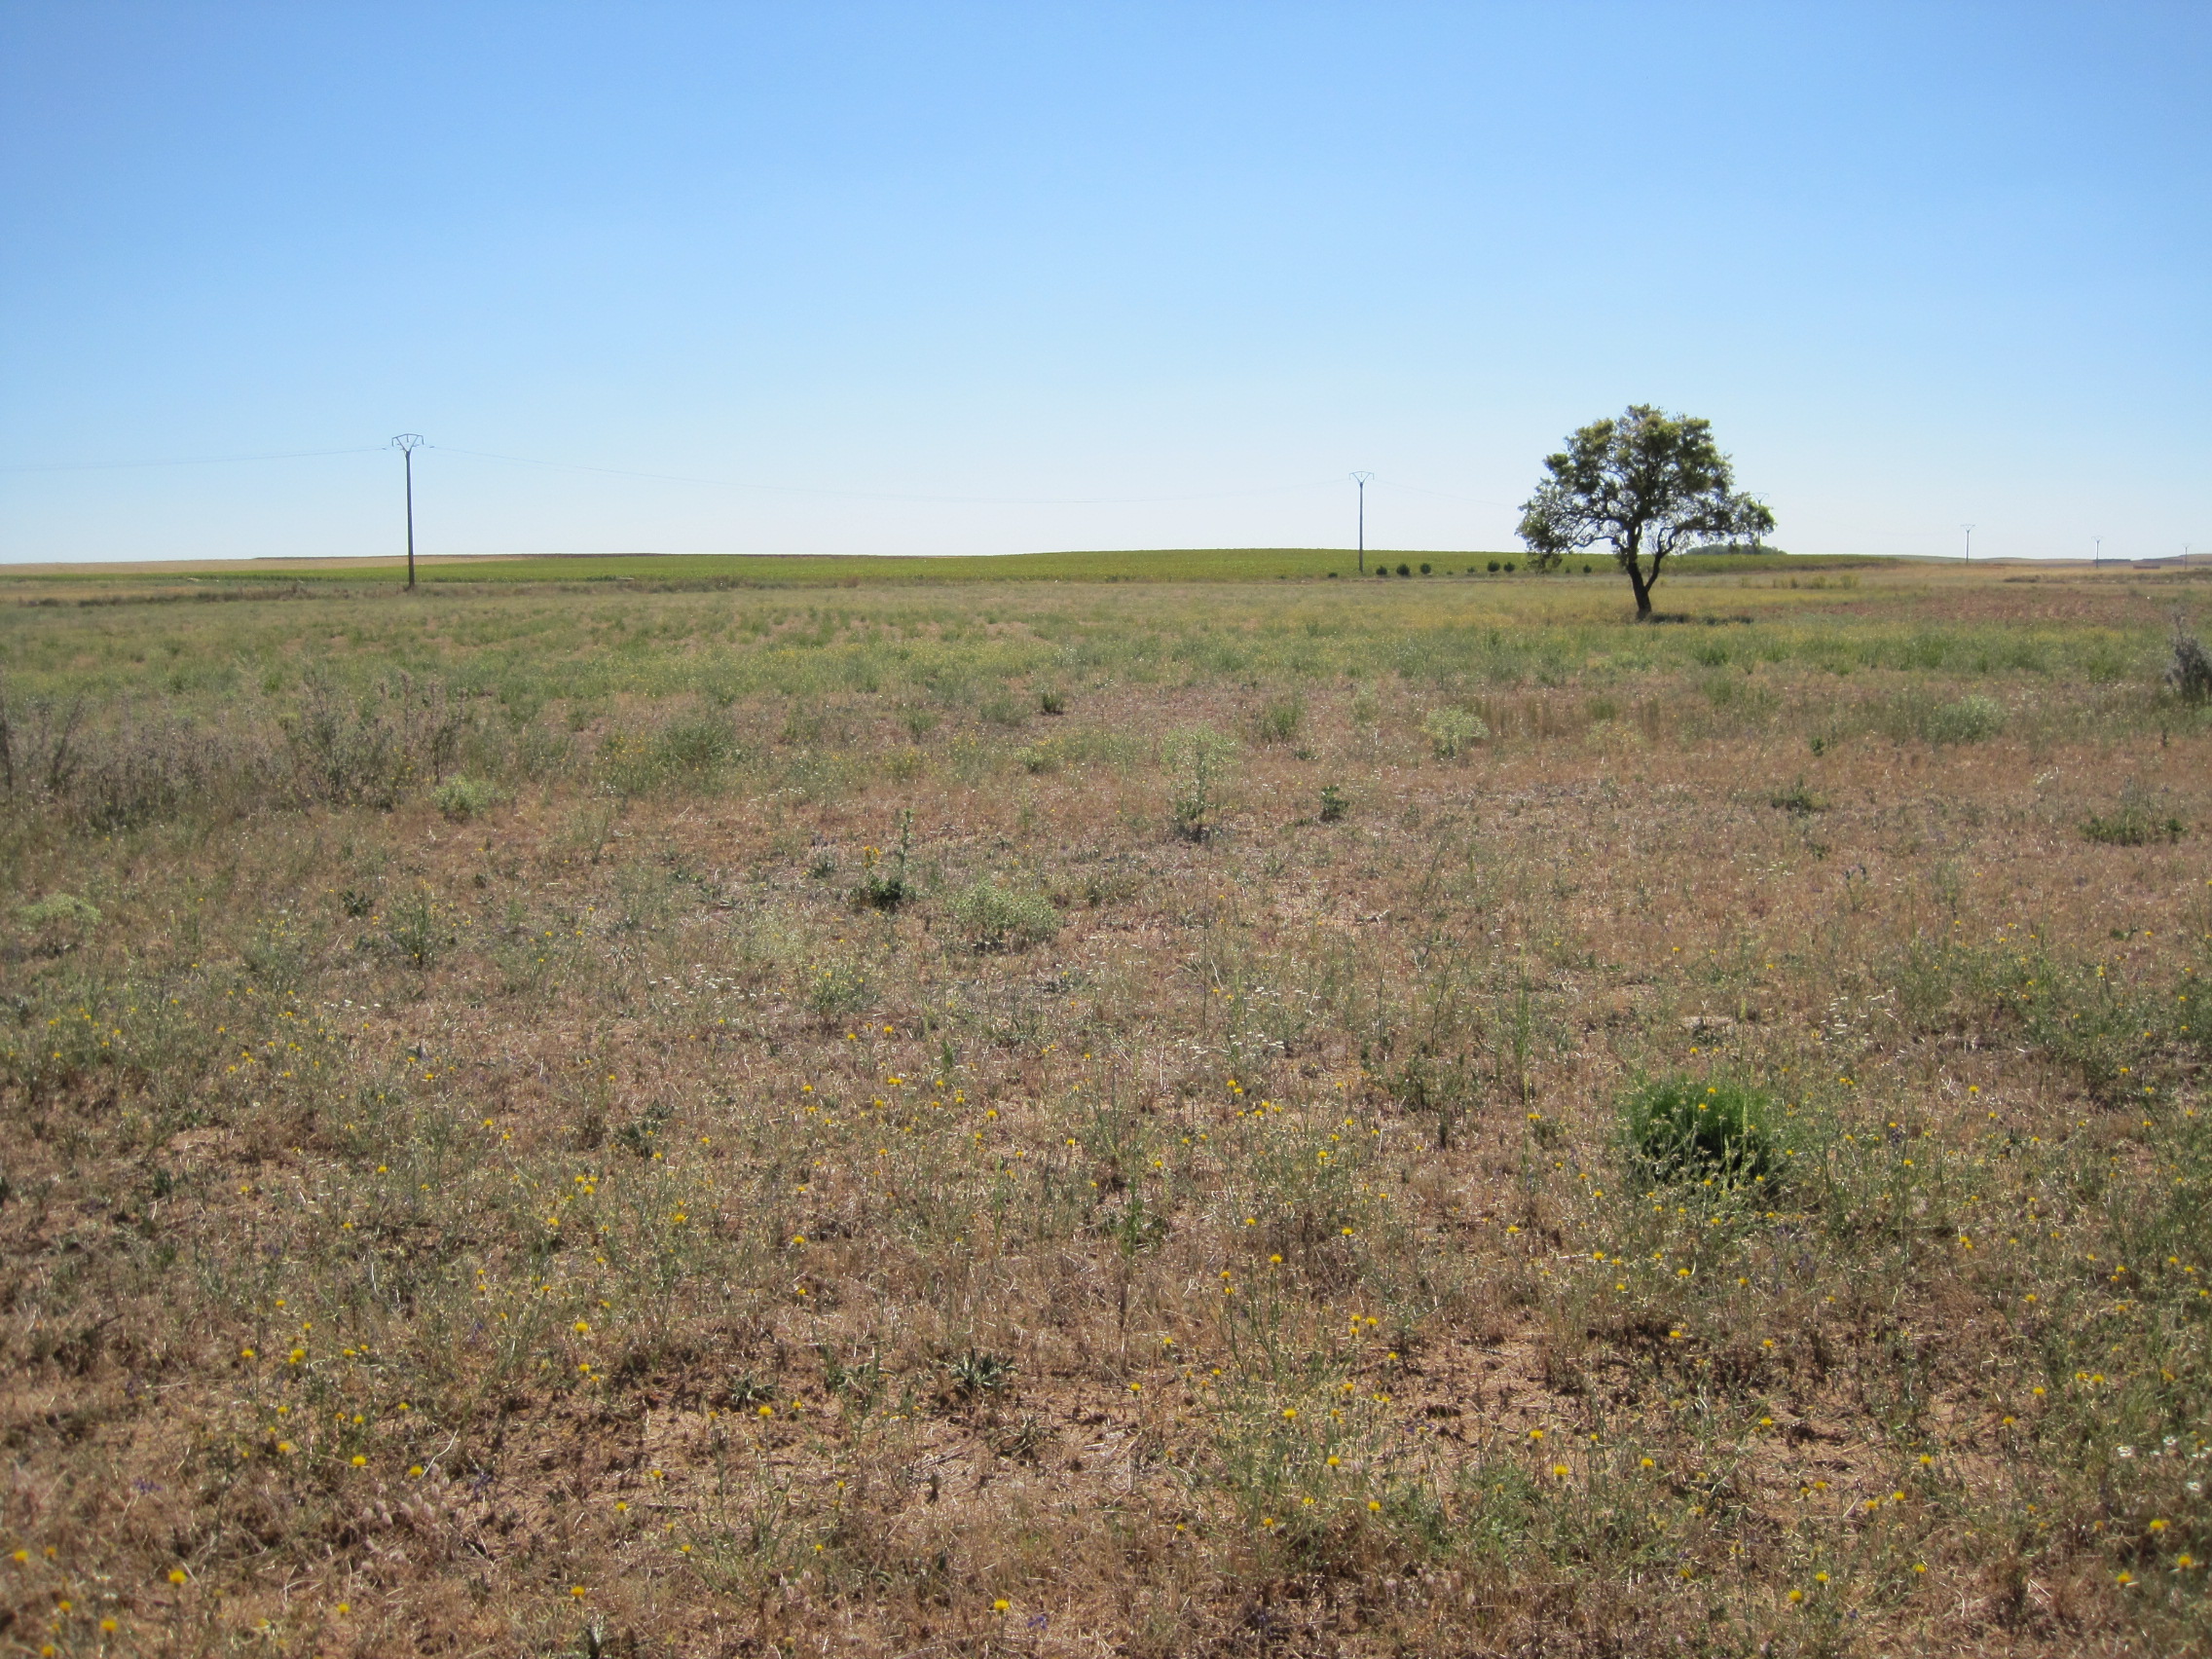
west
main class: Grassland
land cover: Grassland without tree/shrub cover
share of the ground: > 75 %
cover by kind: herbaceous plants 100 %
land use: Semi-natural and natural areas not in use
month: July
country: ES
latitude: 42.0706
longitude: -5.3016
